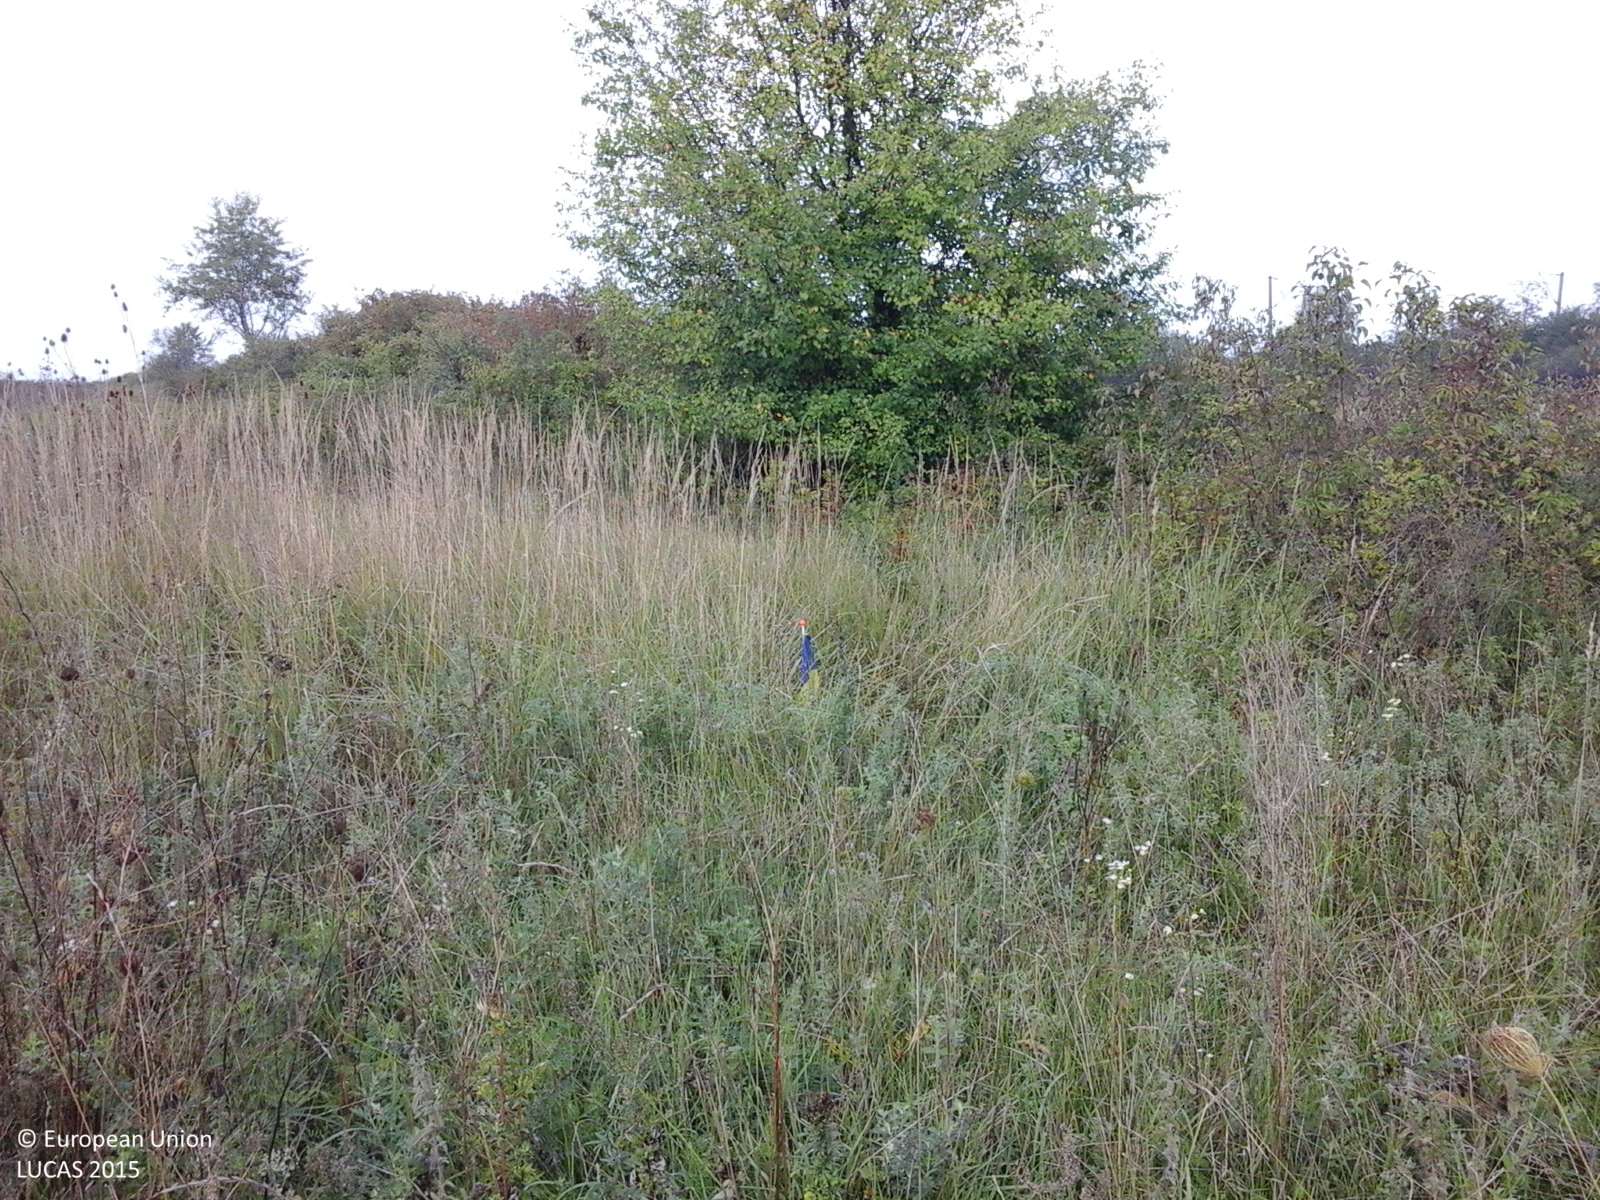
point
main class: Grassland
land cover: Spontaneously vegetated surfaces
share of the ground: > 75 %
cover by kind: herbaceous plants 100 %
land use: Forestry
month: September
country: RO
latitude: 45.0151
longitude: 23.3662
